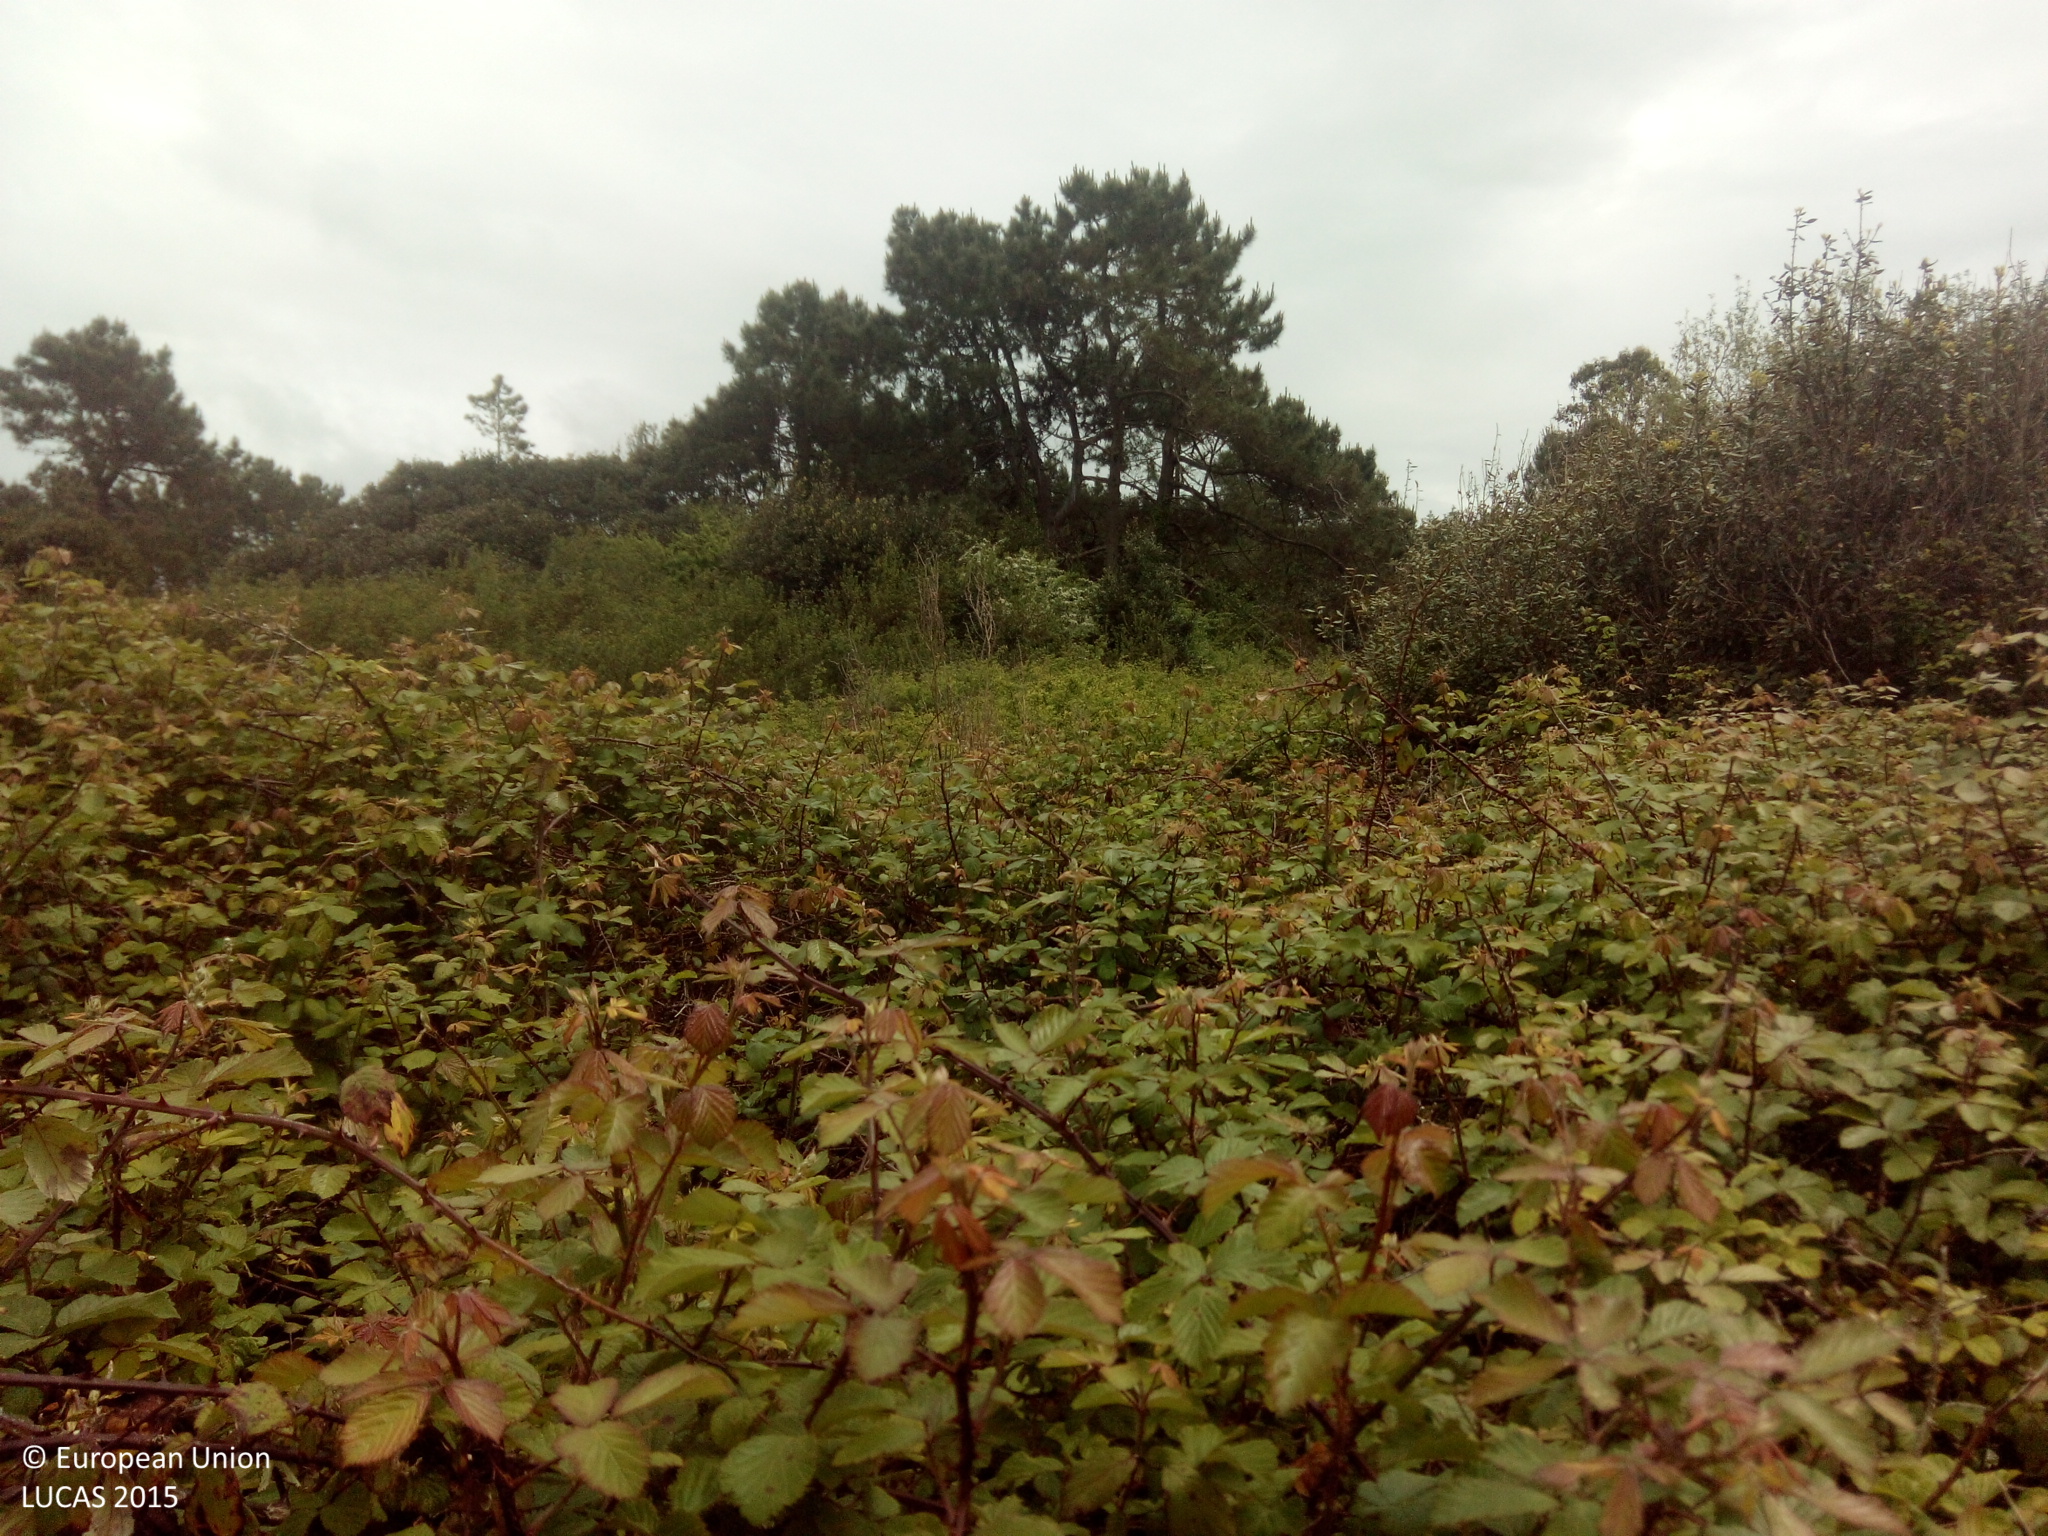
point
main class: Shrubland
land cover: Shrubland with sparse tree cover
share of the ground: > 75 %
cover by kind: shrubs 95 %, broadleaved forest trees 5 %
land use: Abandoned areas
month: April
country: ES
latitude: 42.4774
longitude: -8.9294
